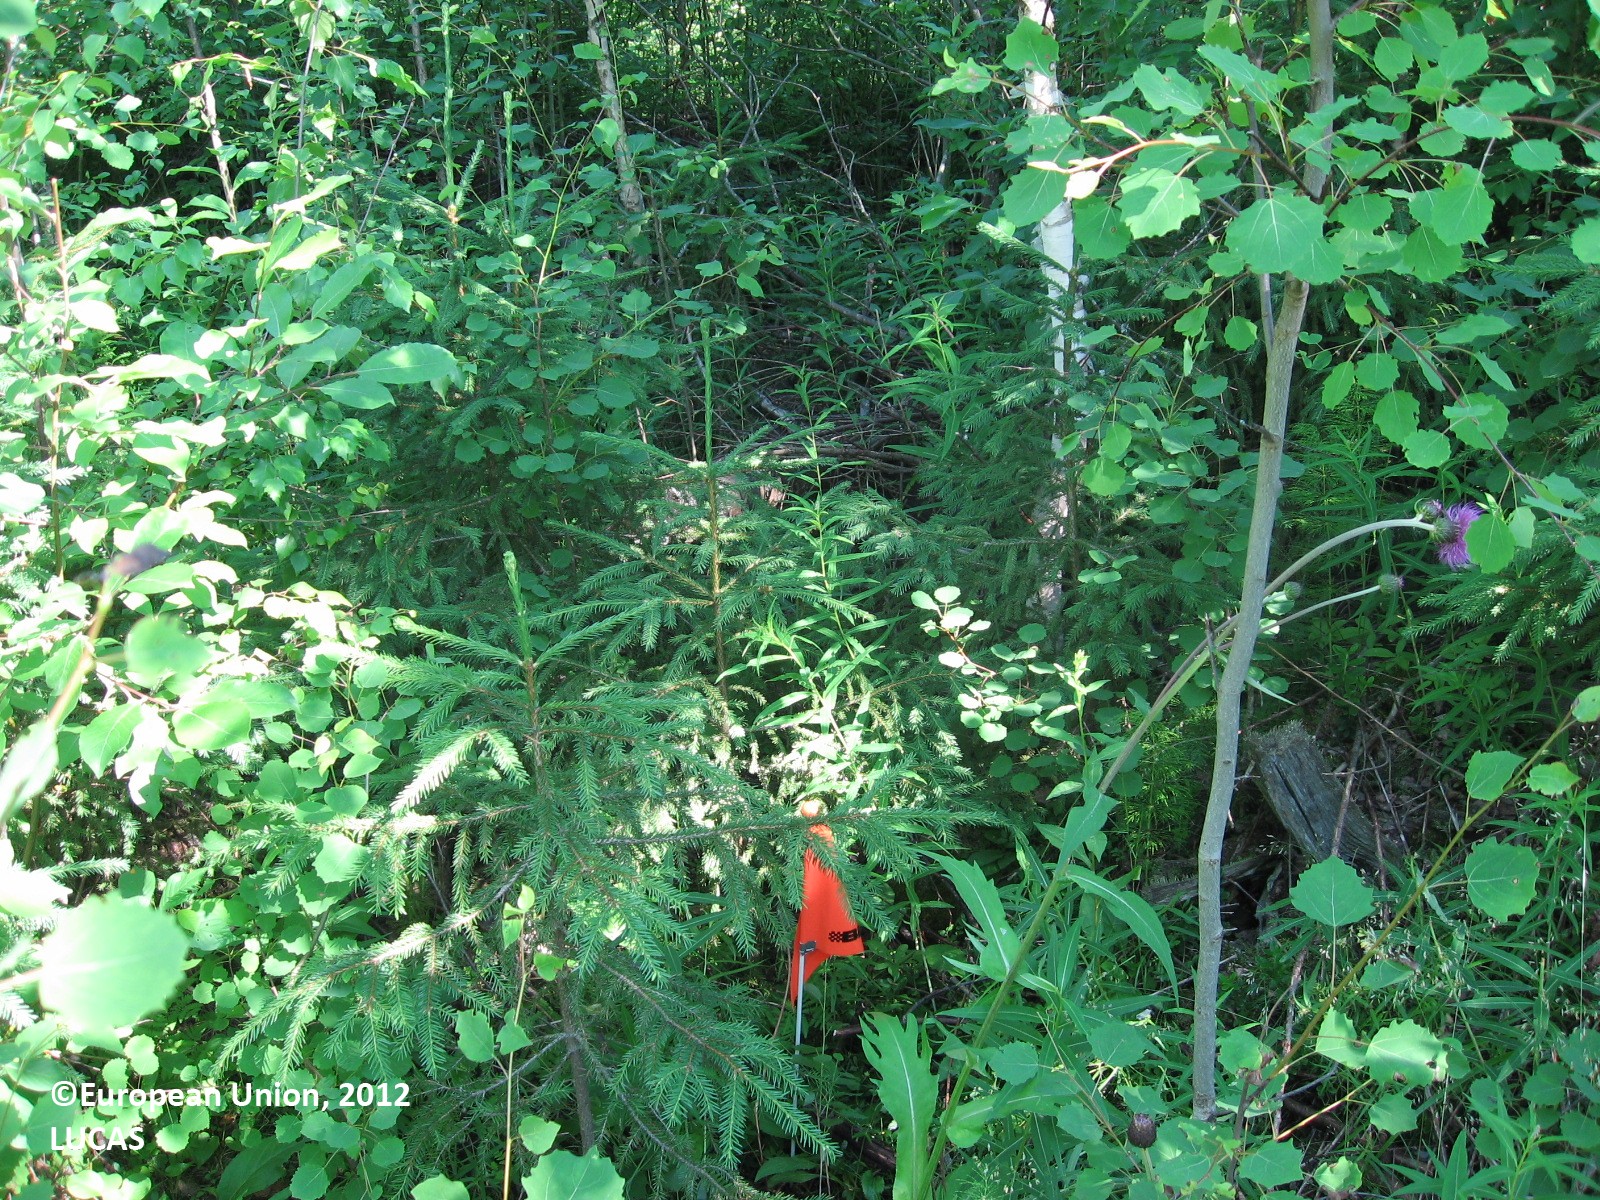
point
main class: Woodland
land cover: Spruce dominated mixed woodland
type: boreal forest
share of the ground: 50 - 75 %
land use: Forestry
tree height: > 5 m
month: July
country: FI
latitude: 60.9533
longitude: 26.4925
